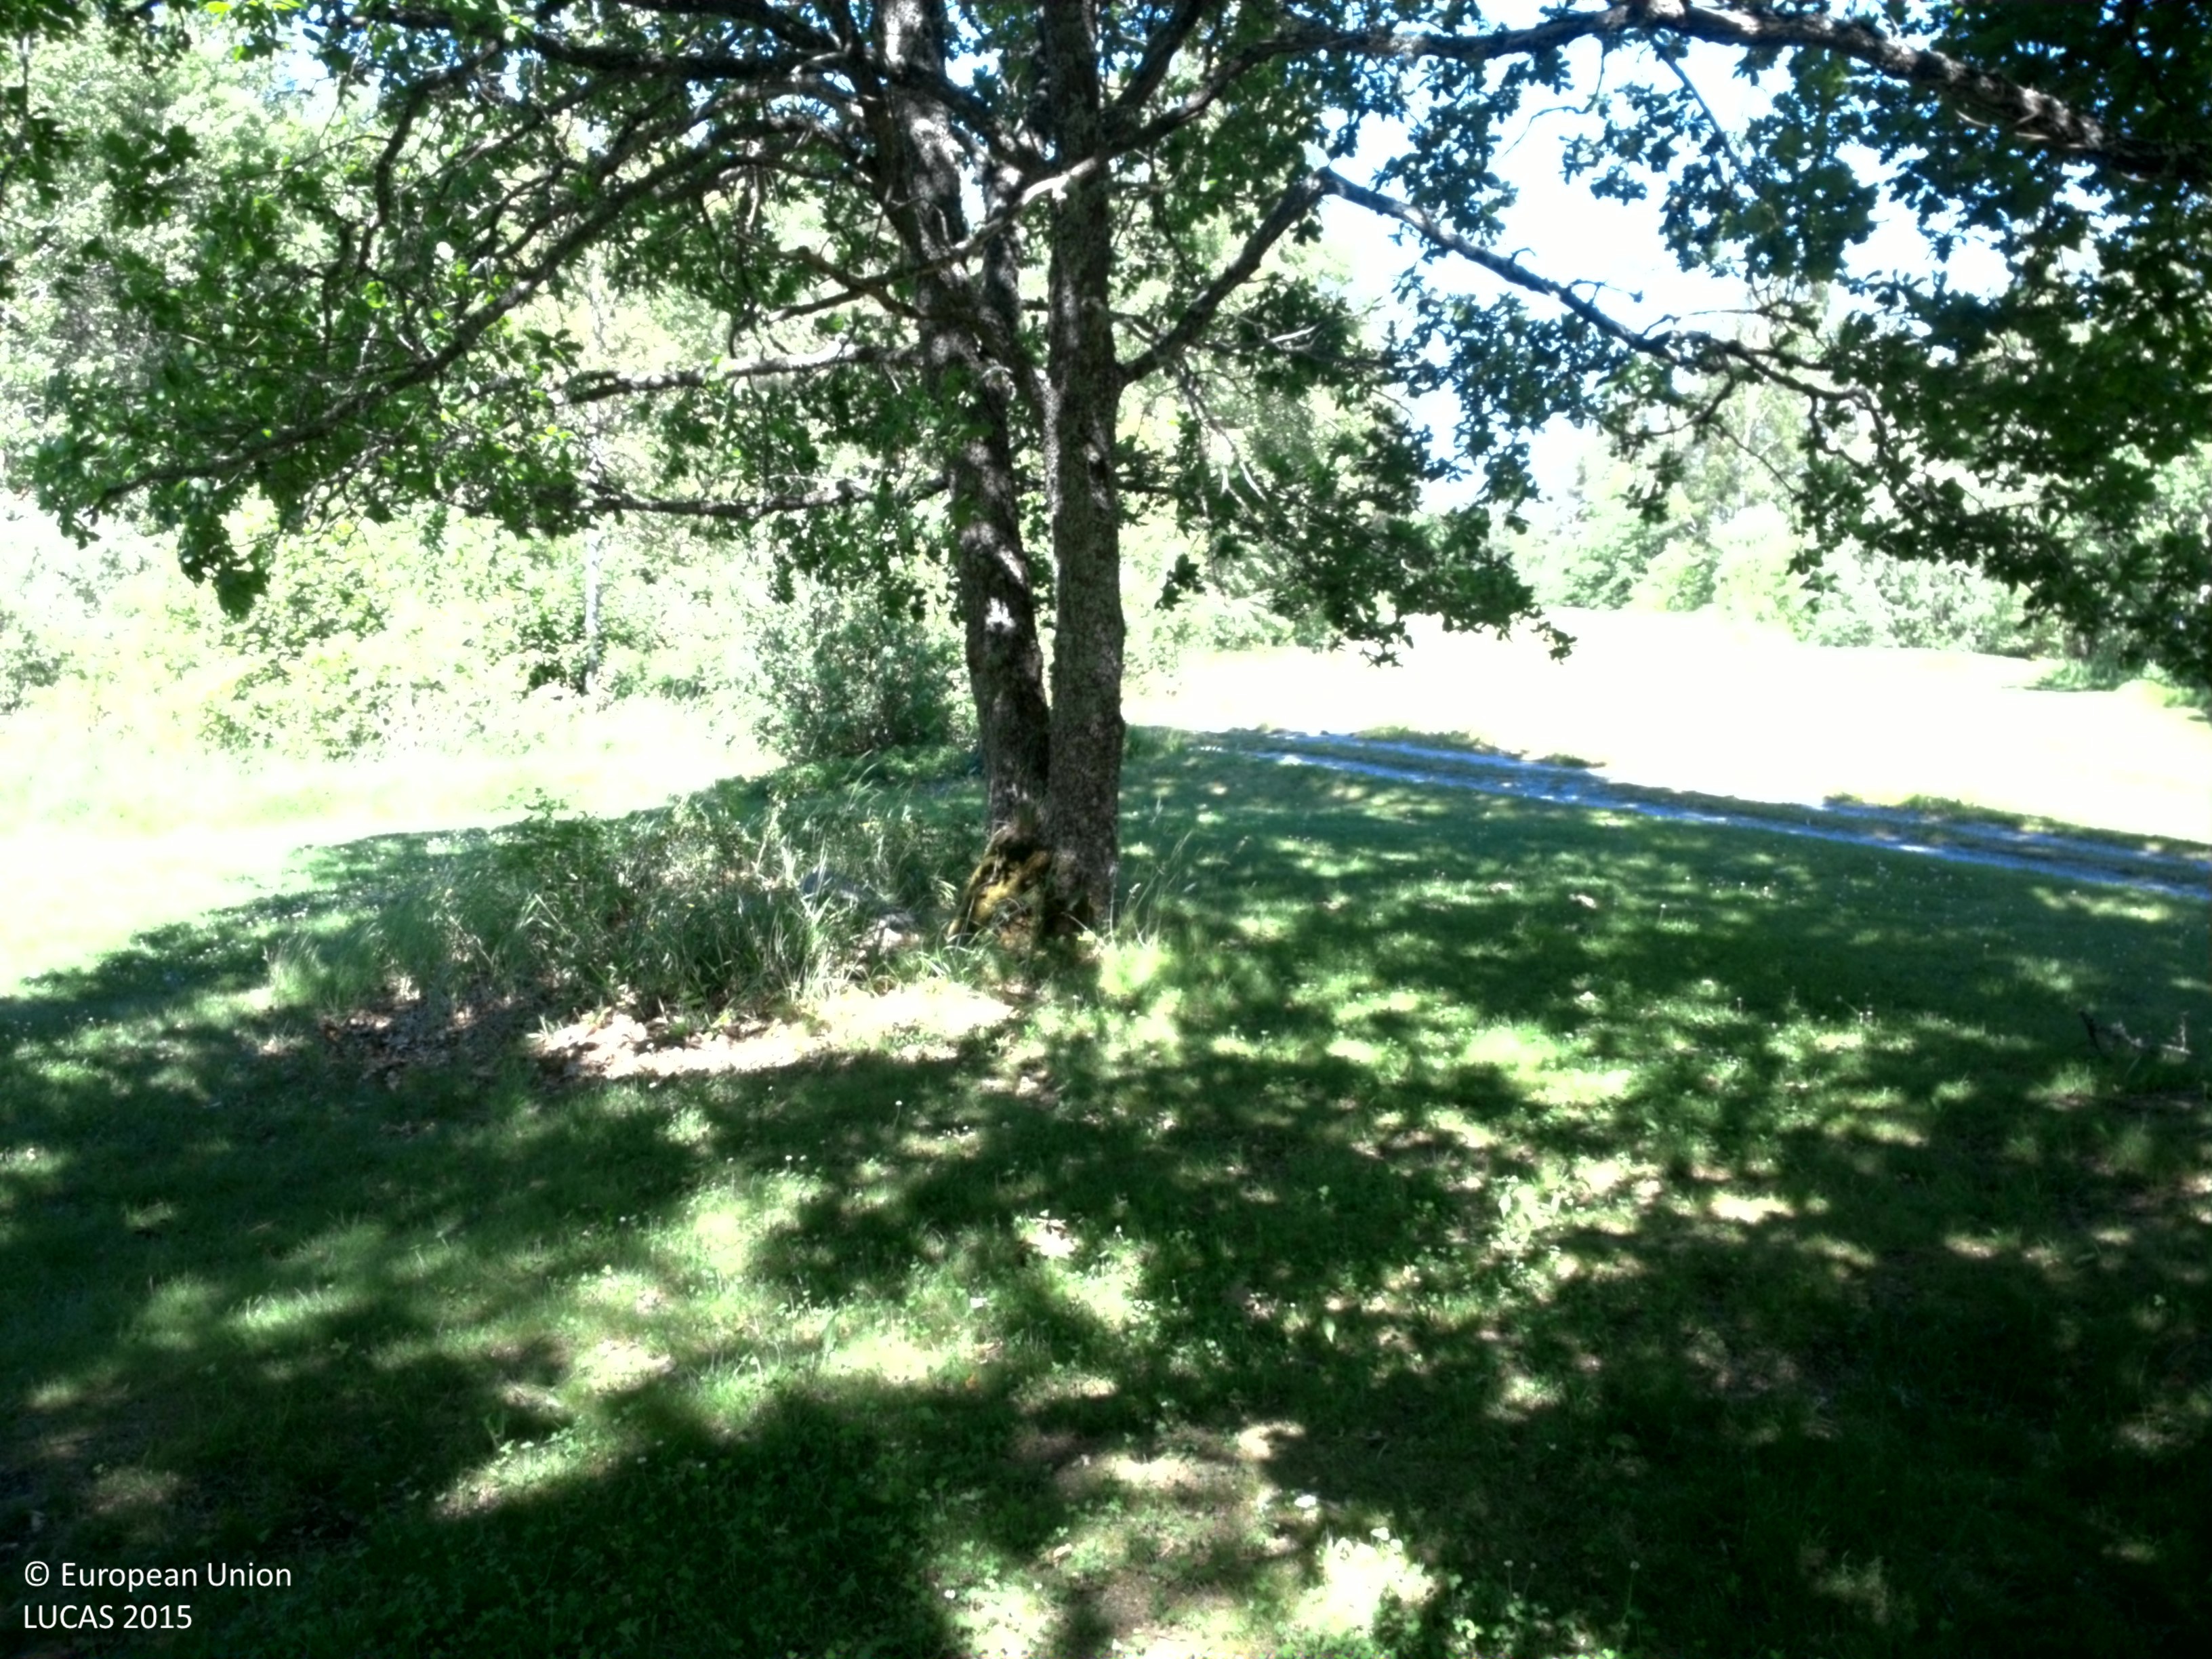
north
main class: Woodland
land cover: Broadleaved woodland
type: hemiboreal forest and nemoral coniferous forest and mixed broadleaved-coniferous forest
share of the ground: 50 - 75 %
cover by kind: broadleaved forest trees 55 %, herbaceous plants 45 %
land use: Sport
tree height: > 5 m
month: July
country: SE
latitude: 59.6986
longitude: 18.3318
